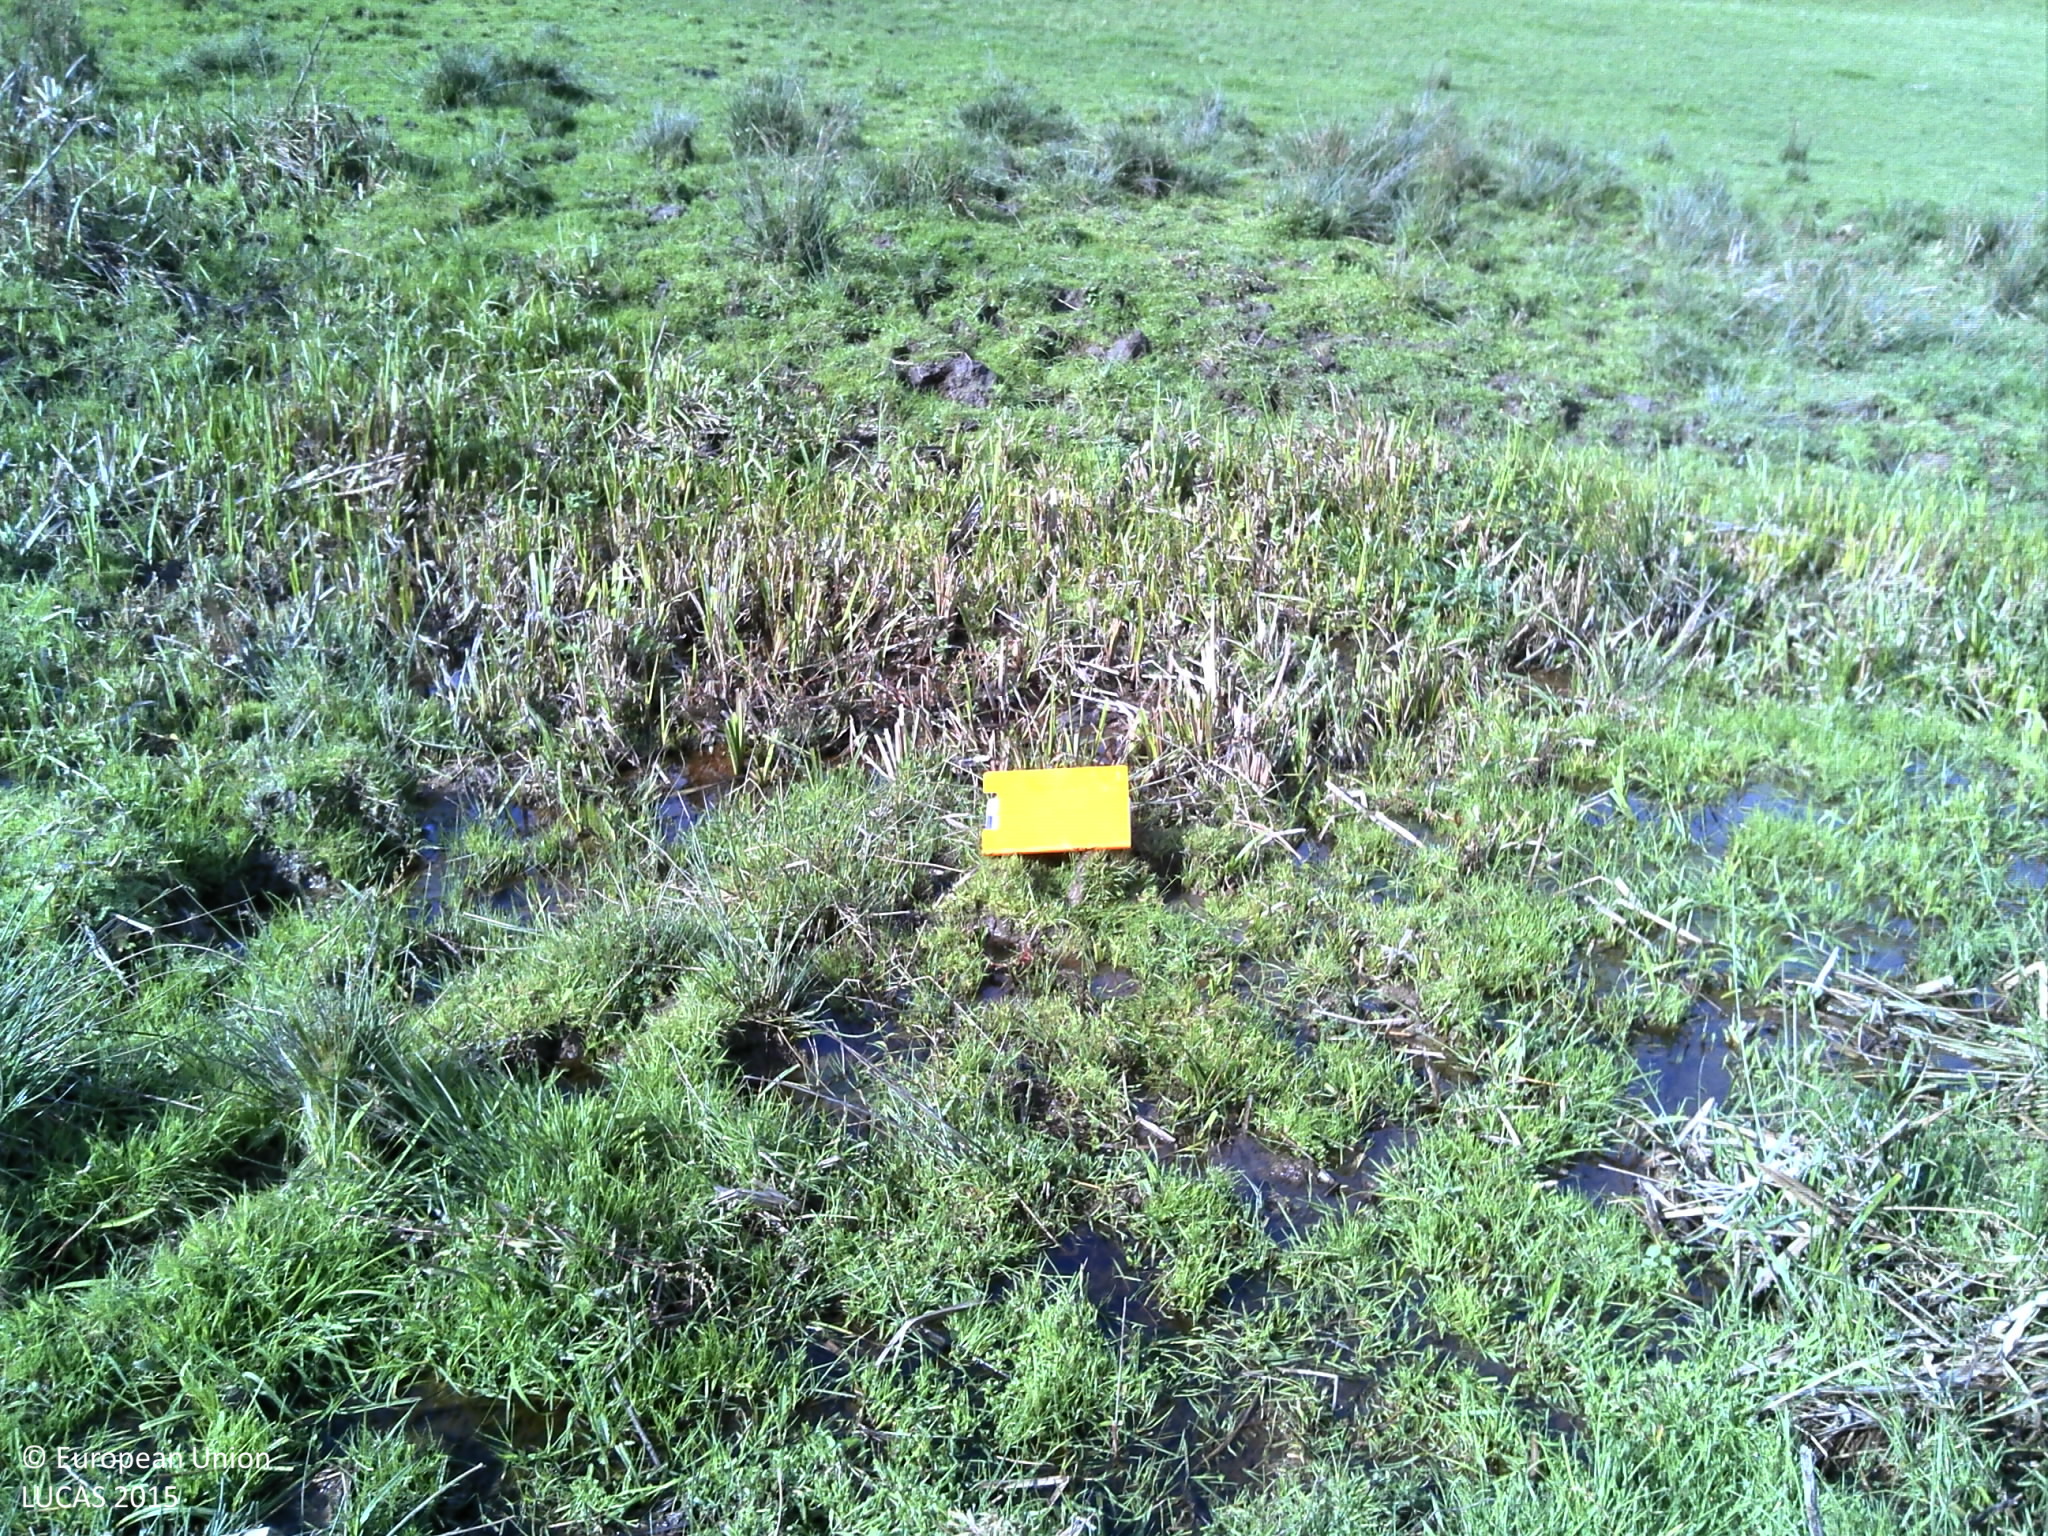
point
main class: Shrubland
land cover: Shrubland without tree cover
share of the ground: > 75 %
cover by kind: shrubs 50 %, herbaceous plants 50 %
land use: Agriculture (excluding fallow land and kitchen gardens)
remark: Temporary flooded
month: October
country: FR
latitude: 46.6330
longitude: 3.9782
